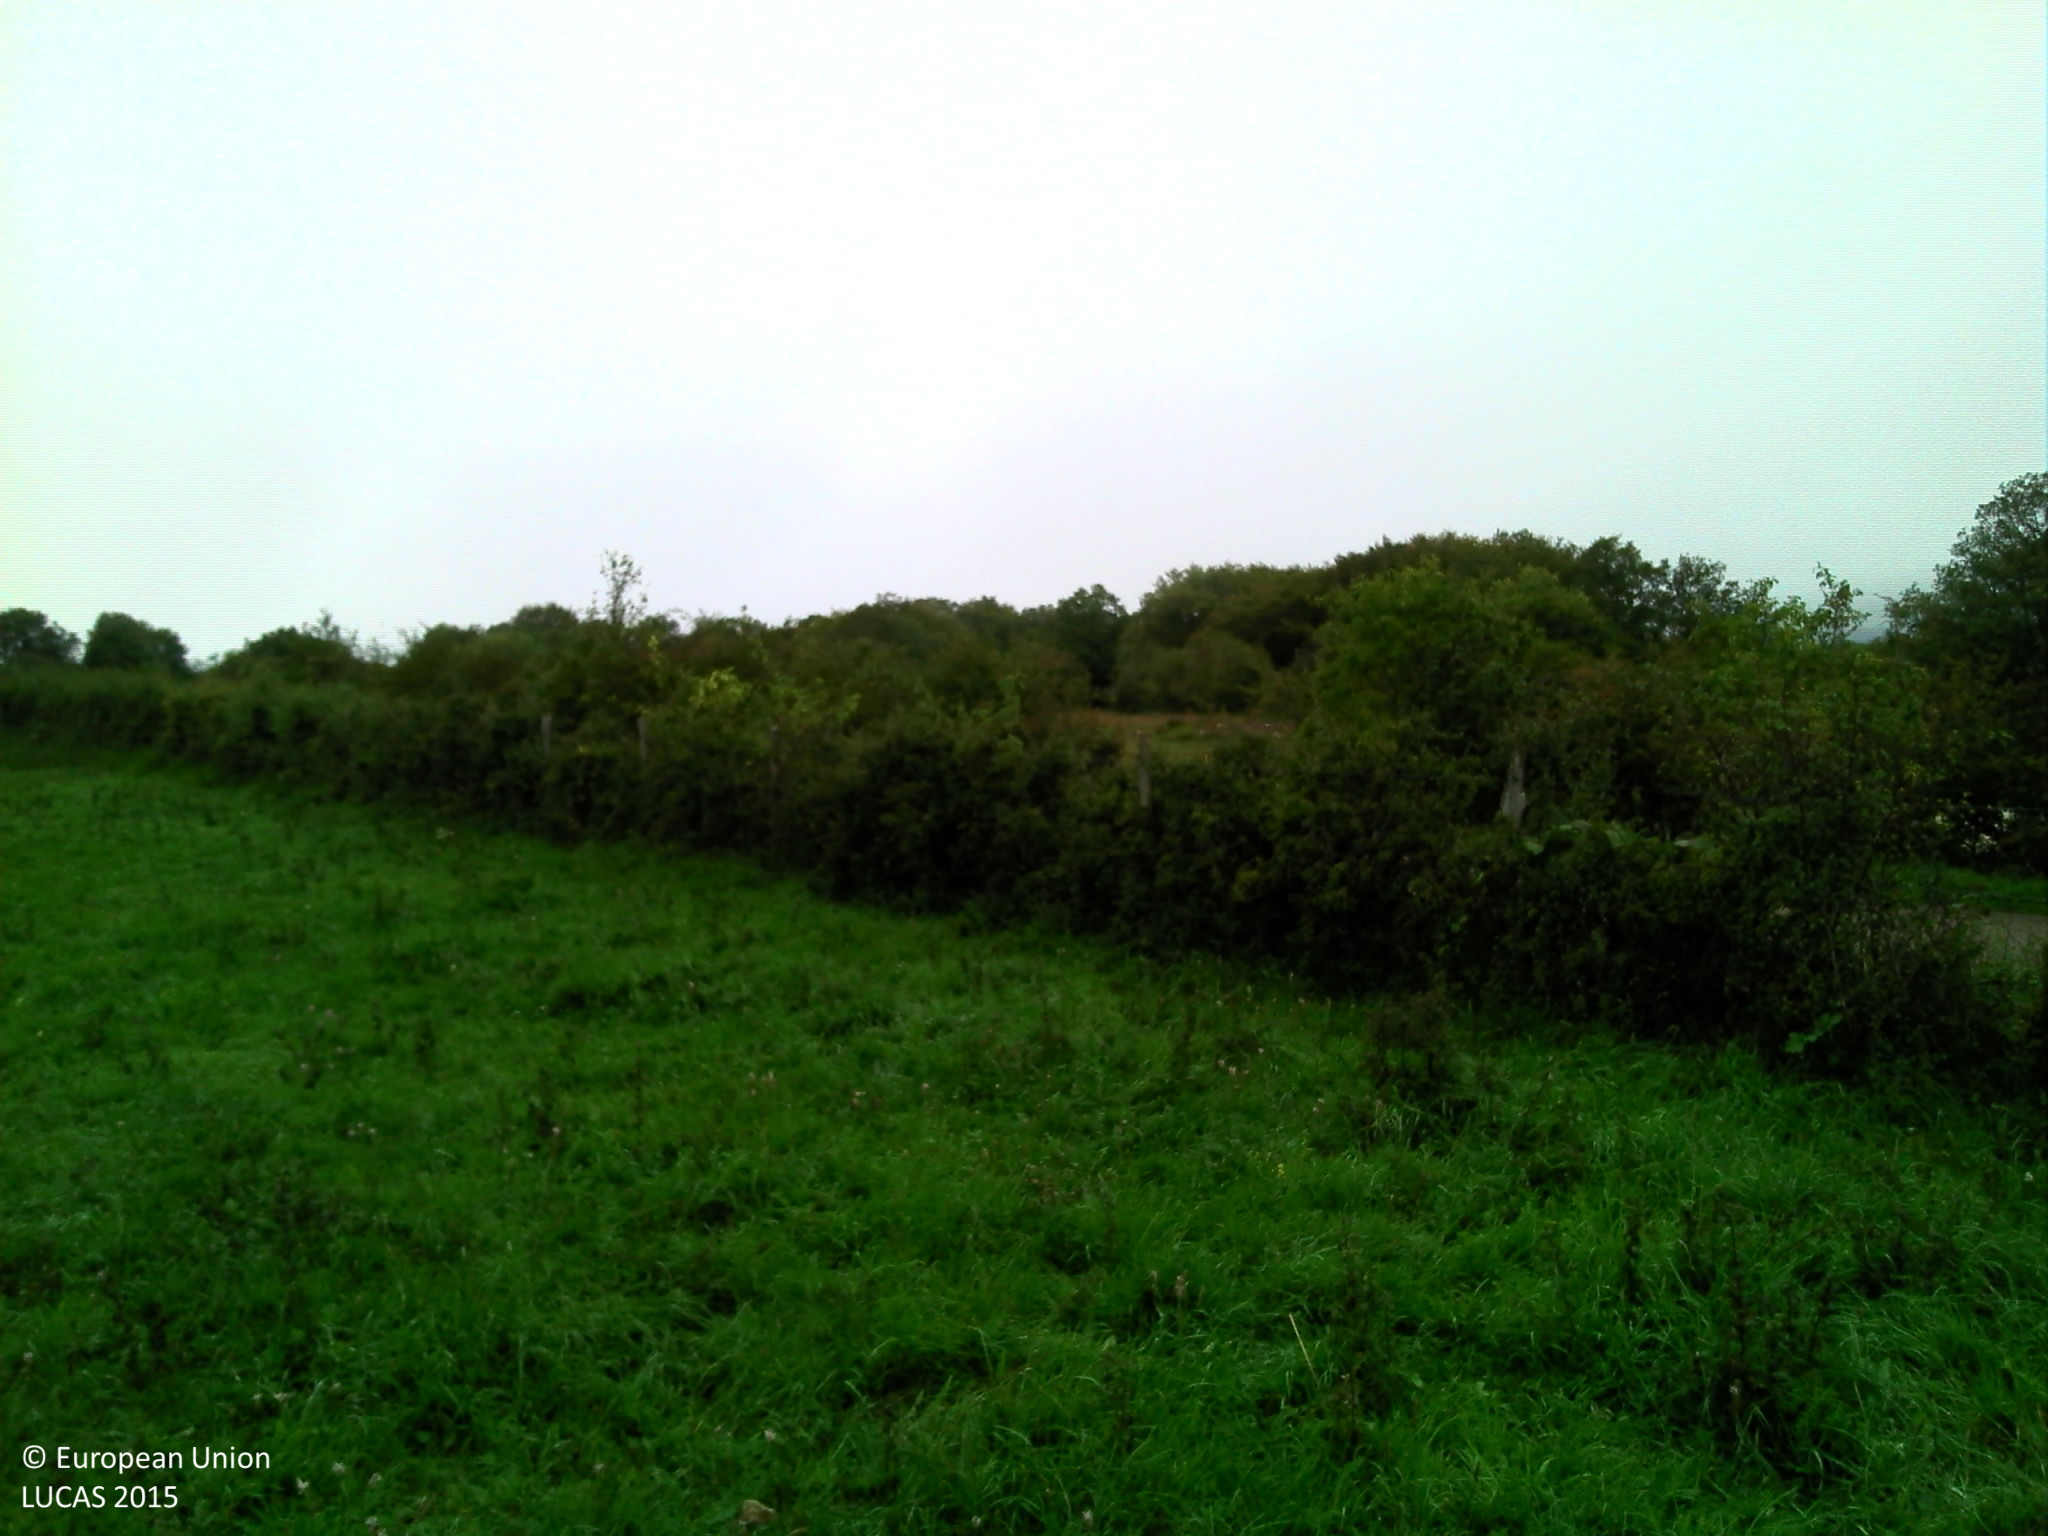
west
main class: Grassland
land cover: Grassland without tree/shrub cover
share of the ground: > 75 %
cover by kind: herbaceous plants 100 %
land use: Agriculture (excluding fallow land and kitchen gardens)
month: September
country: FR
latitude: 47.1241
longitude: 4.7409
